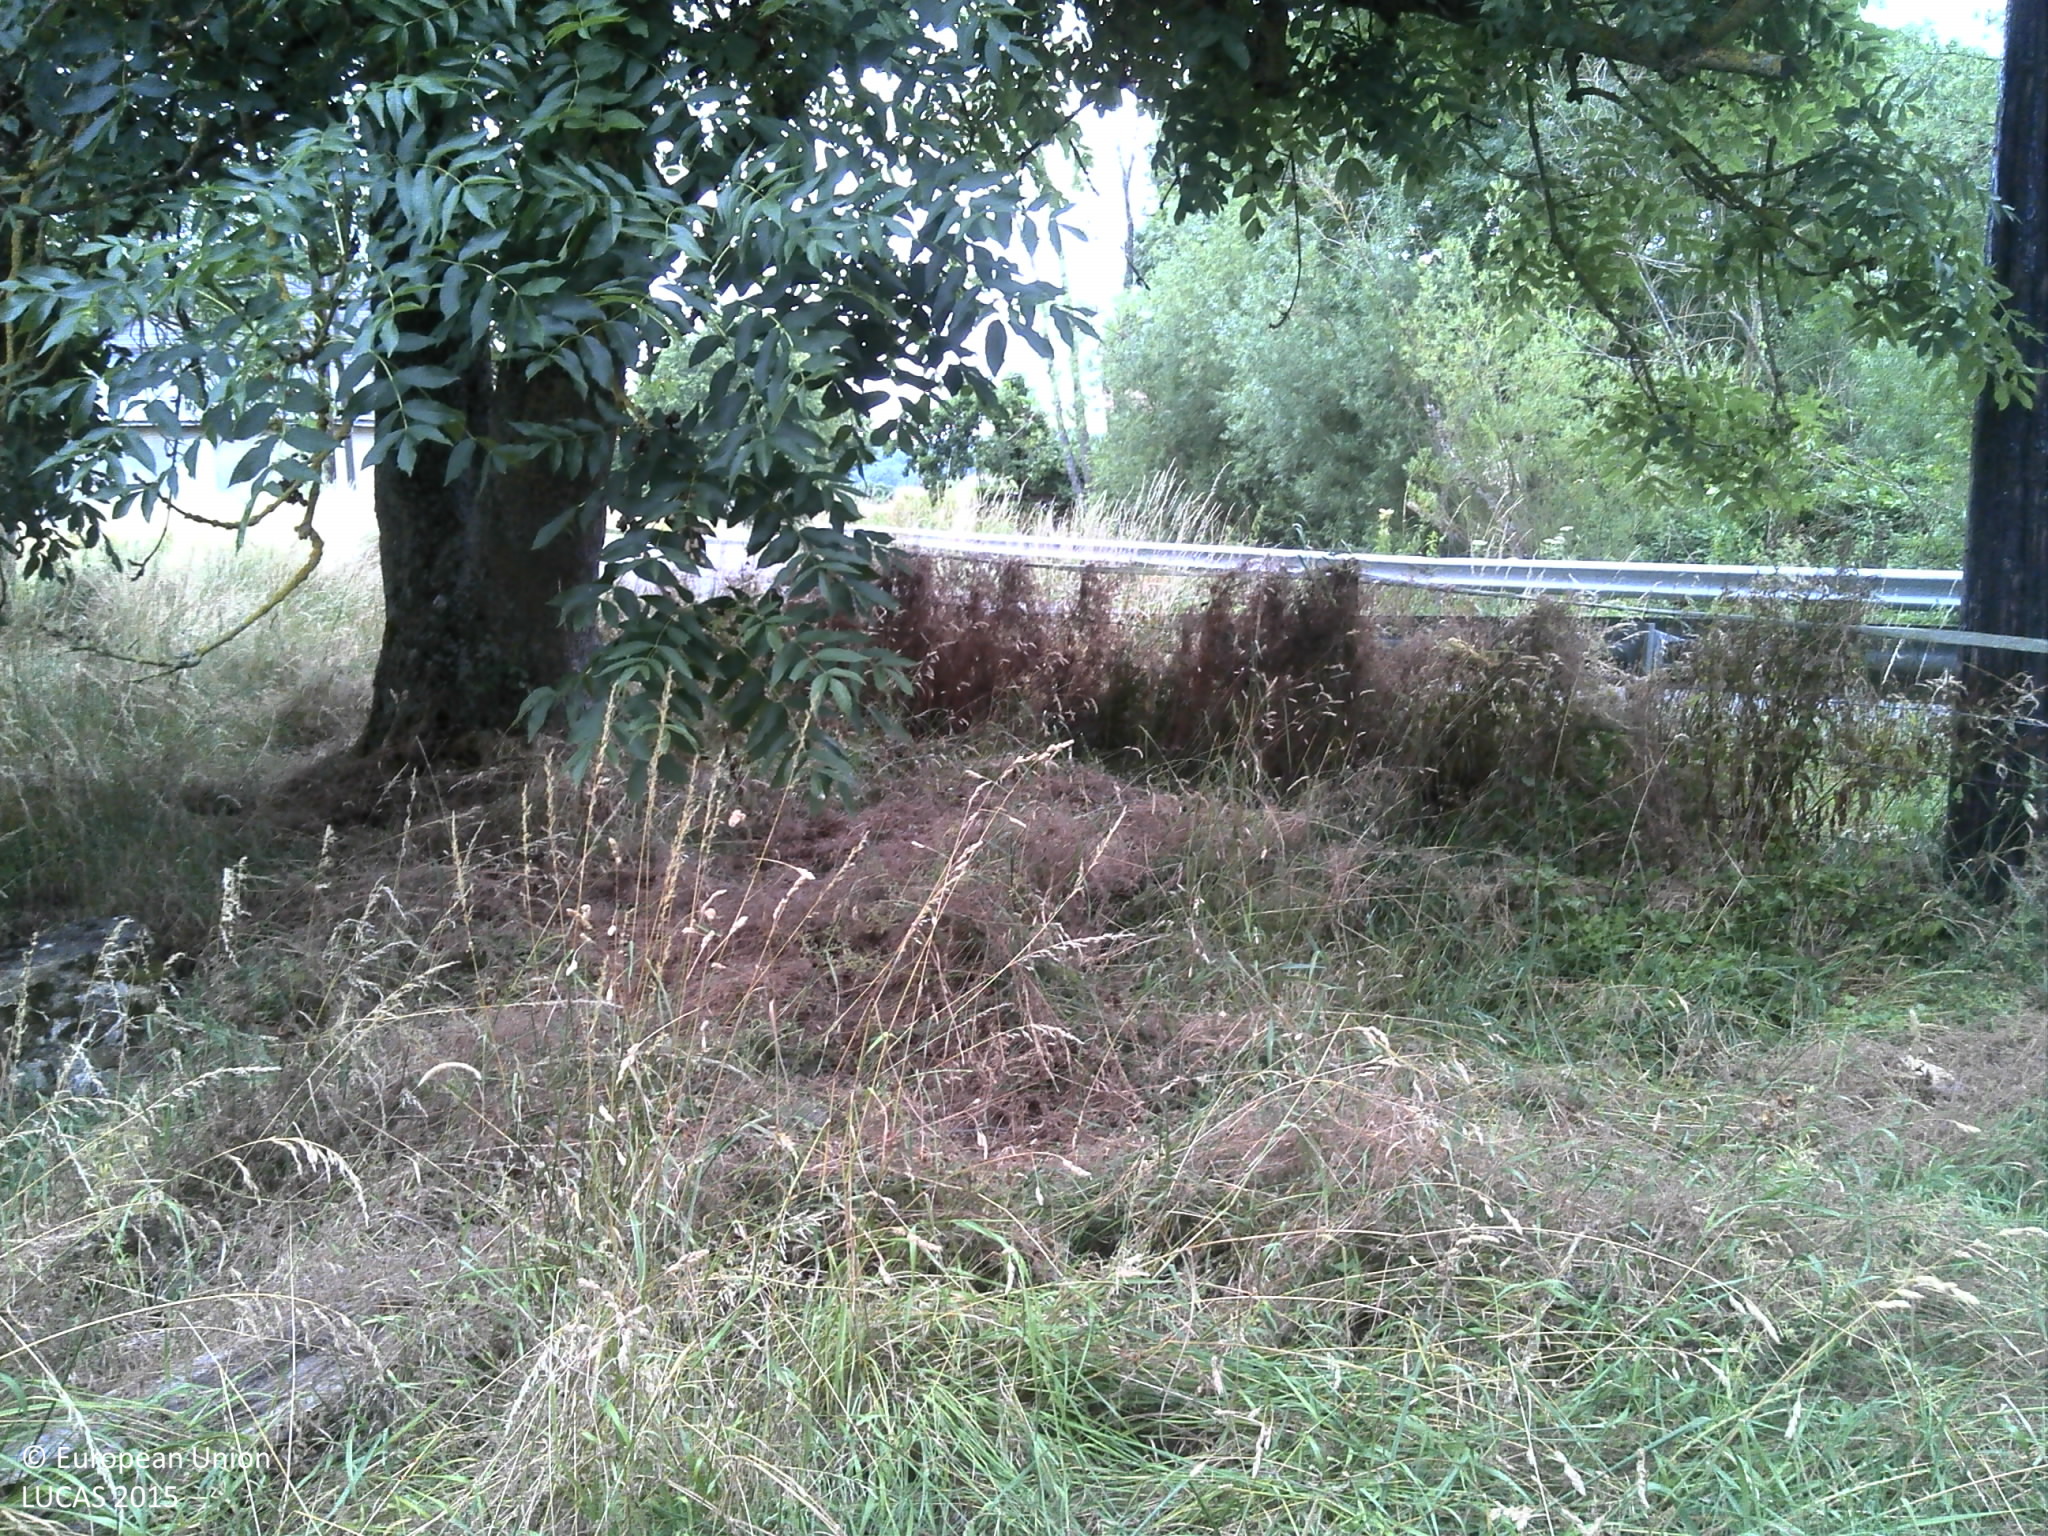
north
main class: Grassland
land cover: Grassland with sparse tree/shrub cover
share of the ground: > 75 %
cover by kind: herbaceous plants 95 %, broadleaved forest trees 5 %
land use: Agriculture (excluding fallow land and kitchen gardens)
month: July
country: FR
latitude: 49.4130
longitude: 4.7178
